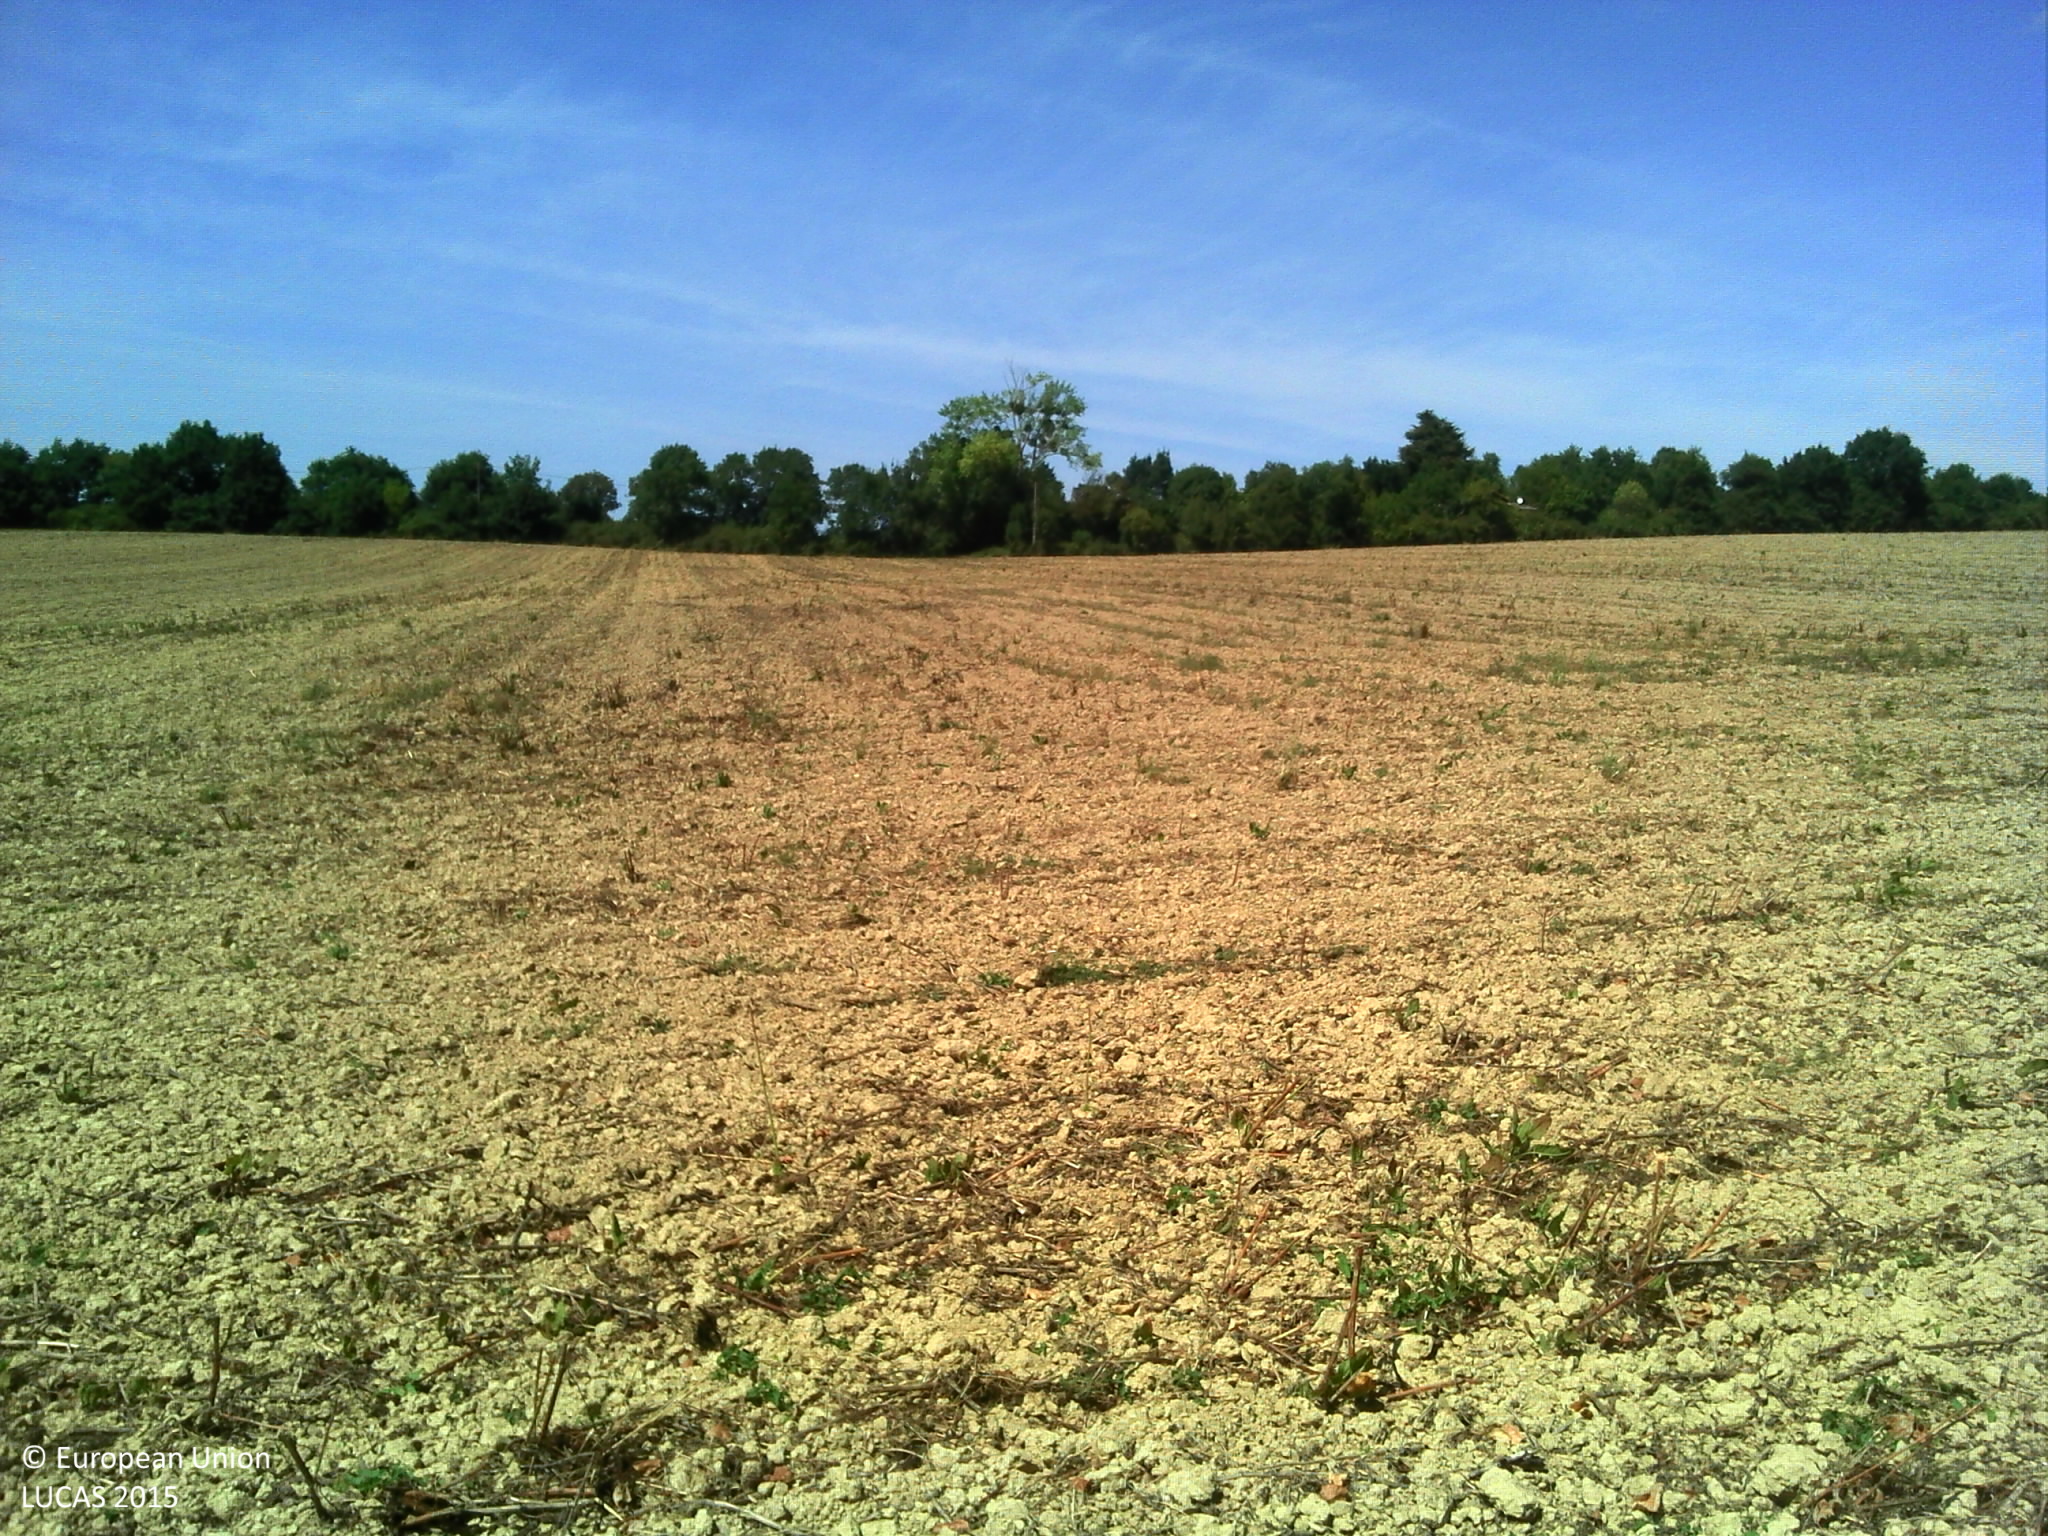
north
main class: Cropland
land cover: Dry pulses
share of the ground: 25 - 50 %
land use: Agriculture (excluding fallow land and kitchen gardens)
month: August
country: FR
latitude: 46.7737
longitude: -1.0740
